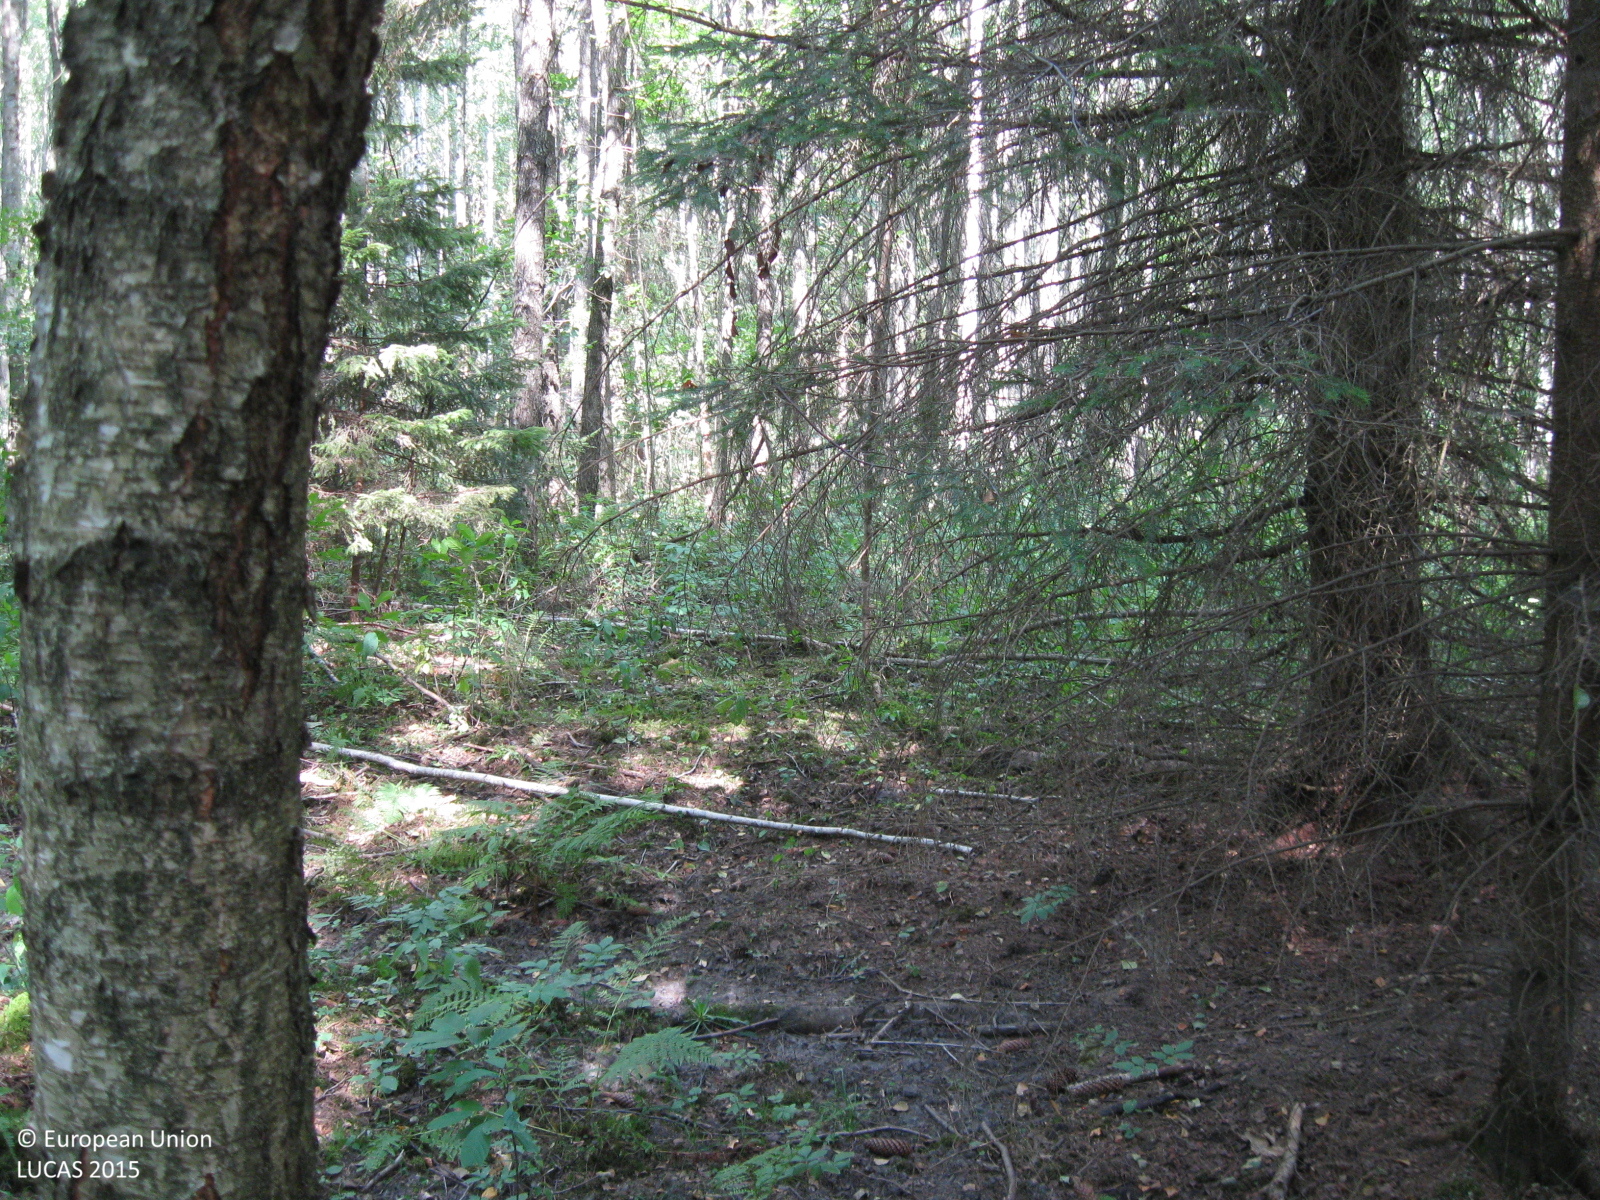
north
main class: Woodland
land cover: Spruce dominated mixed woodland
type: hemiboreal forest and nemoral coniferous forest and mixed broadleaved-coniferous forest
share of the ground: > 75 %
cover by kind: broadleaved forest trees 65 %, coniferous forest trees 30 %, herbaceous plants 5 %
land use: Forestry
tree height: > 5 m
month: August
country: LT
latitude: 55.2106
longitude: 22.8445
